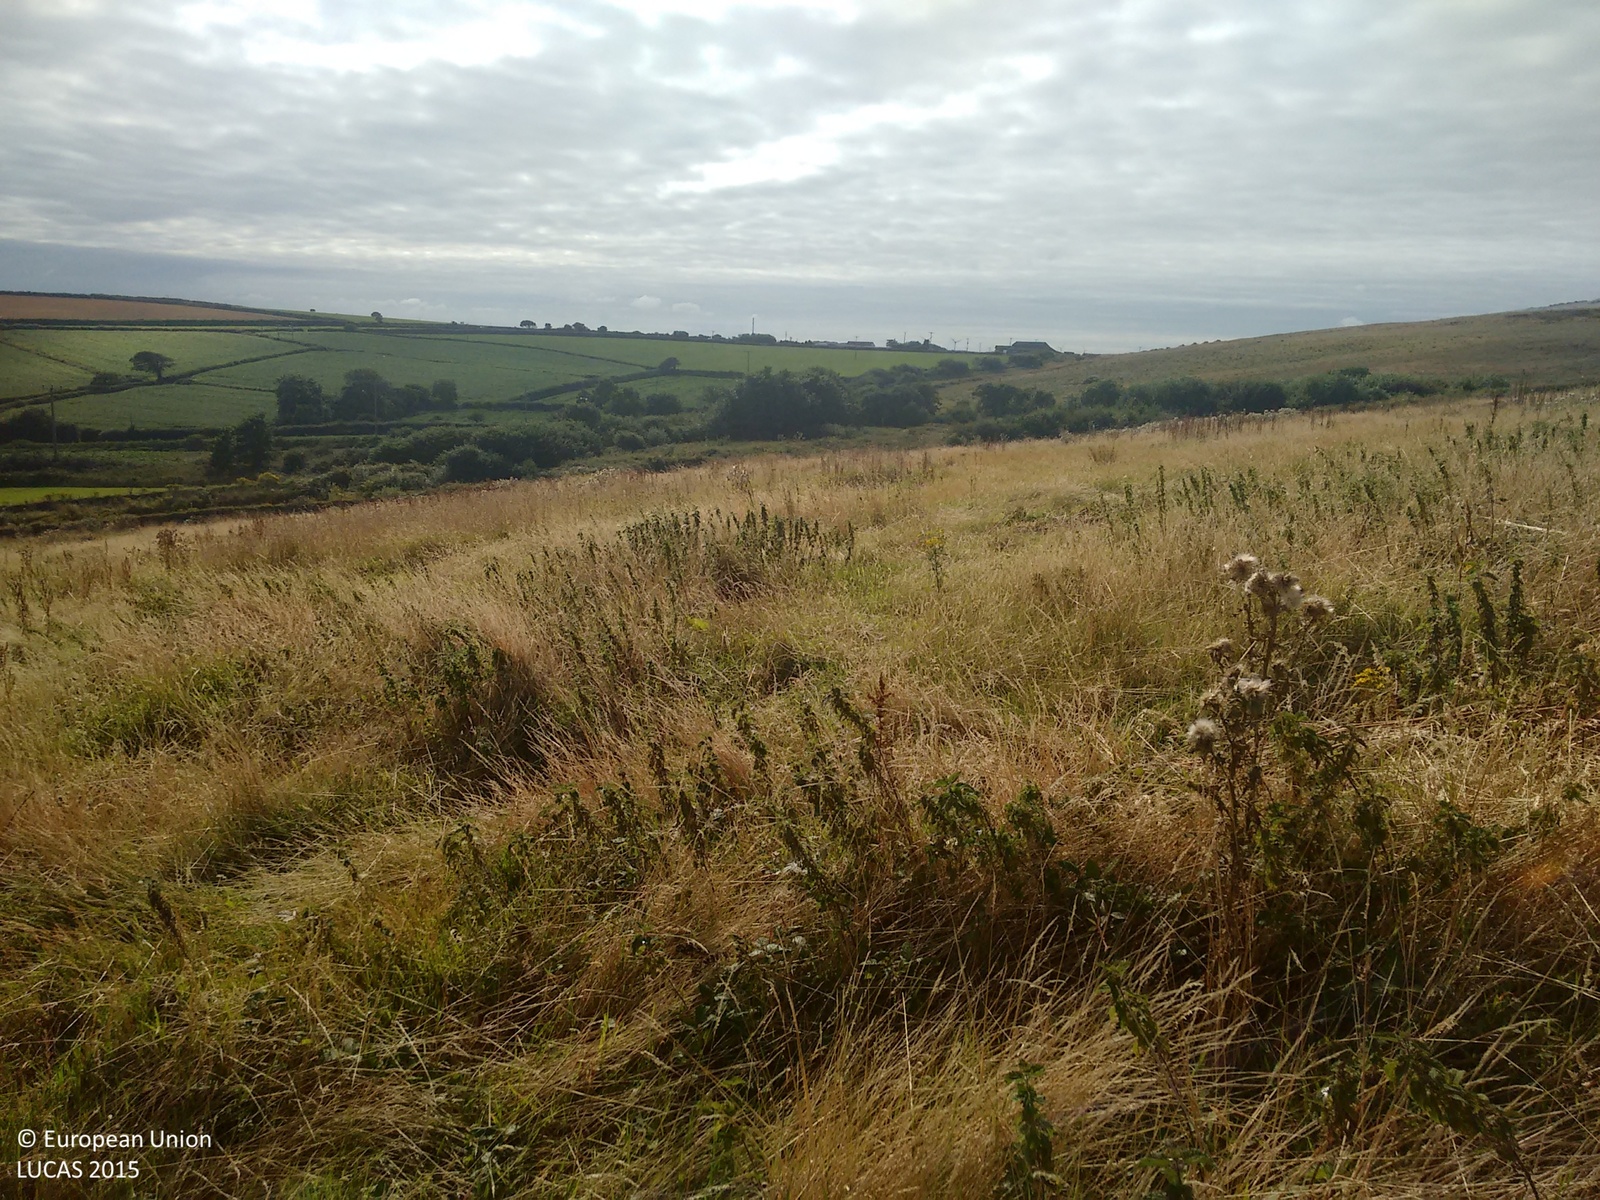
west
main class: Grassland
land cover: Spontaneously vegetated surfaces
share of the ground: > 75 %
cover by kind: herbaceous plants 100 %
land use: Semi-natural and natural areas not in use
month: August
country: GB
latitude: 50.3488
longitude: -4.9118
